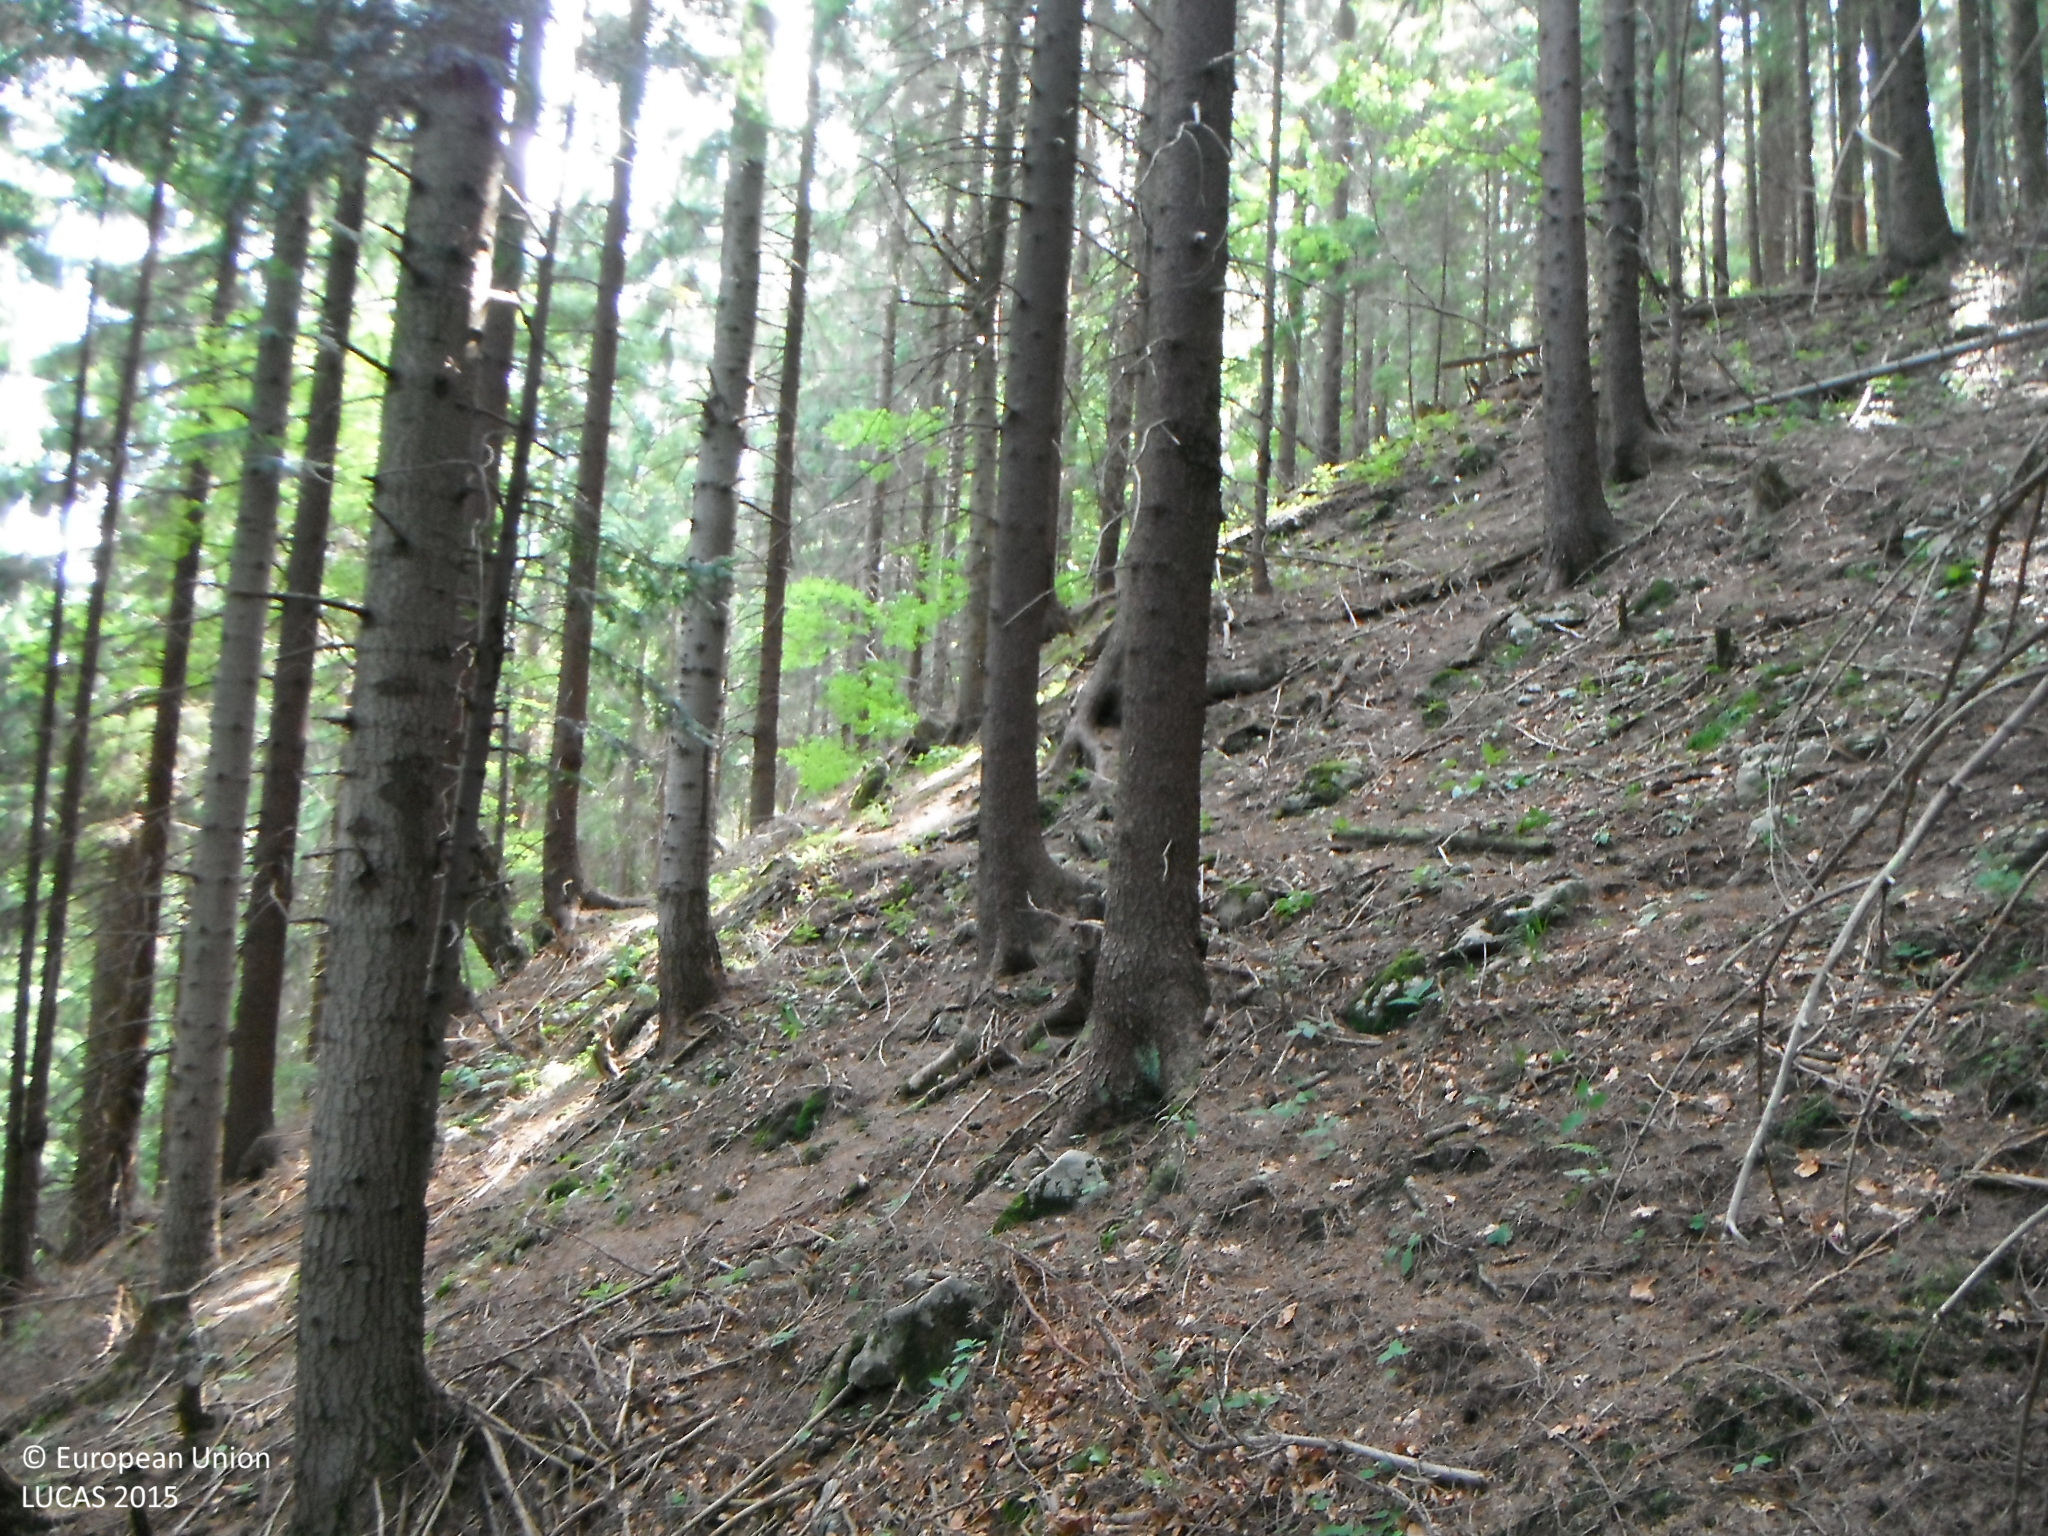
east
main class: Woodland
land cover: Spruce dominated coniferous woodland
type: alpine coniferous forest
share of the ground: > 75 %
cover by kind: coniferous forest trees 95 %, broadleaved forest trees 5 %
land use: Forestry
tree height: > 5 m
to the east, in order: Spruce dominated coniferous woodland
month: July
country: SK
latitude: 49.2560
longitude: 19.1324
